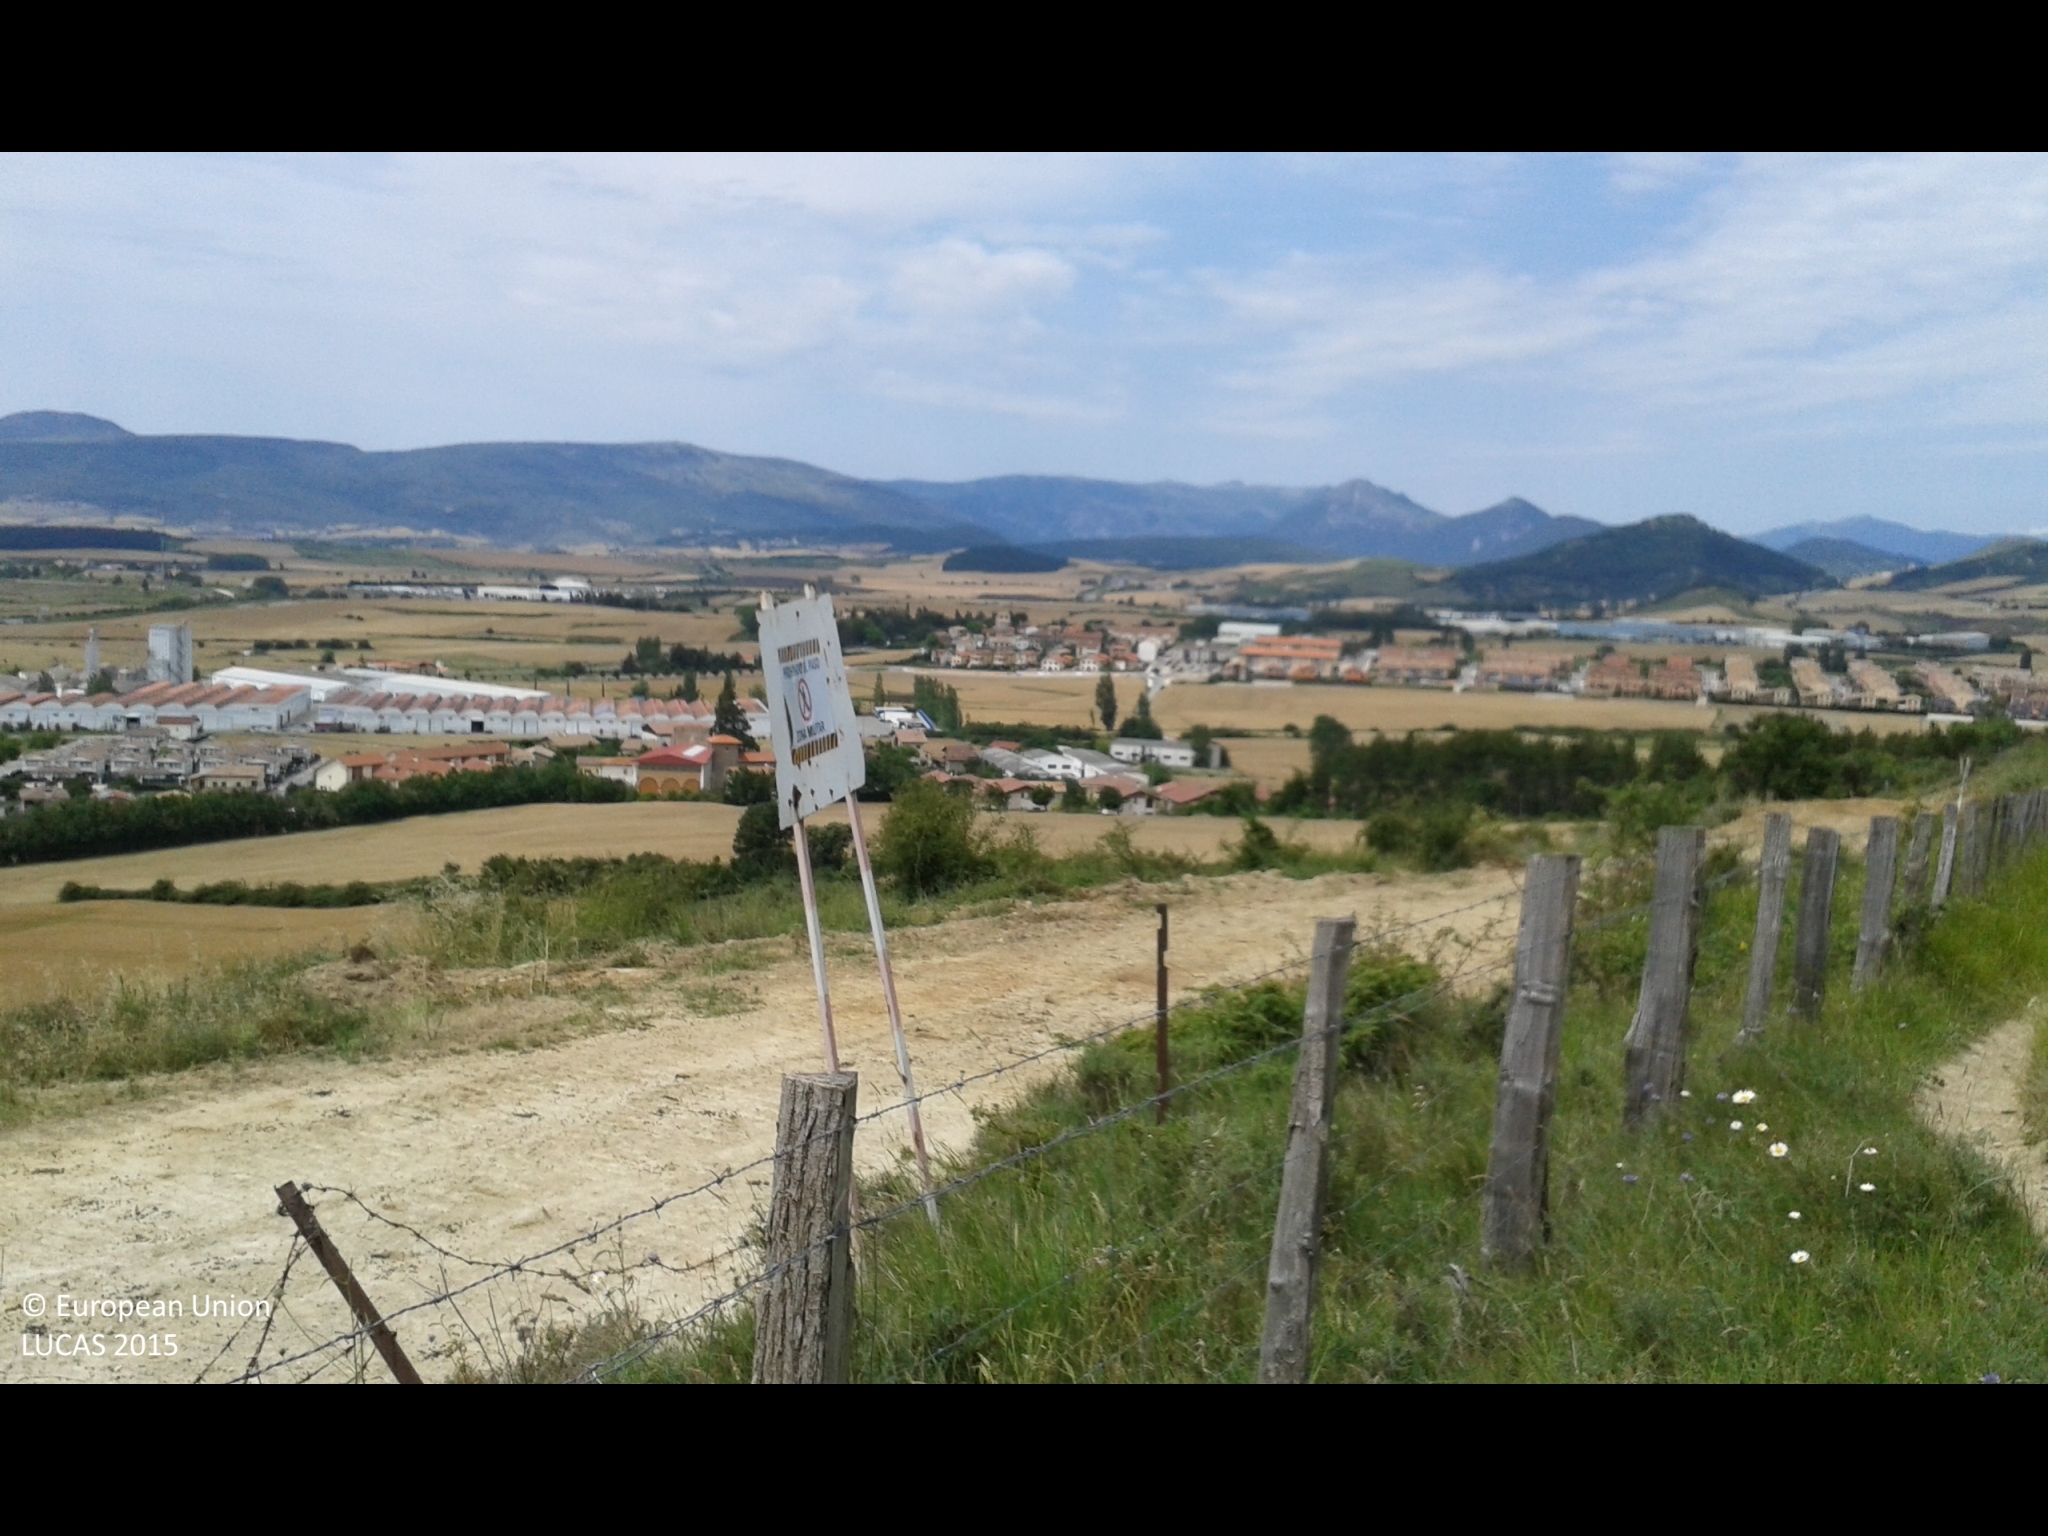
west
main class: Grassland
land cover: Grassland without tree/shrub cover
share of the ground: > 75 %
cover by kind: consolidated bare surface 60 %, herbaceous plants 40 %
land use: Community services
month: June
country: ES
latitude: 42.8510
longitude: -1.6773
